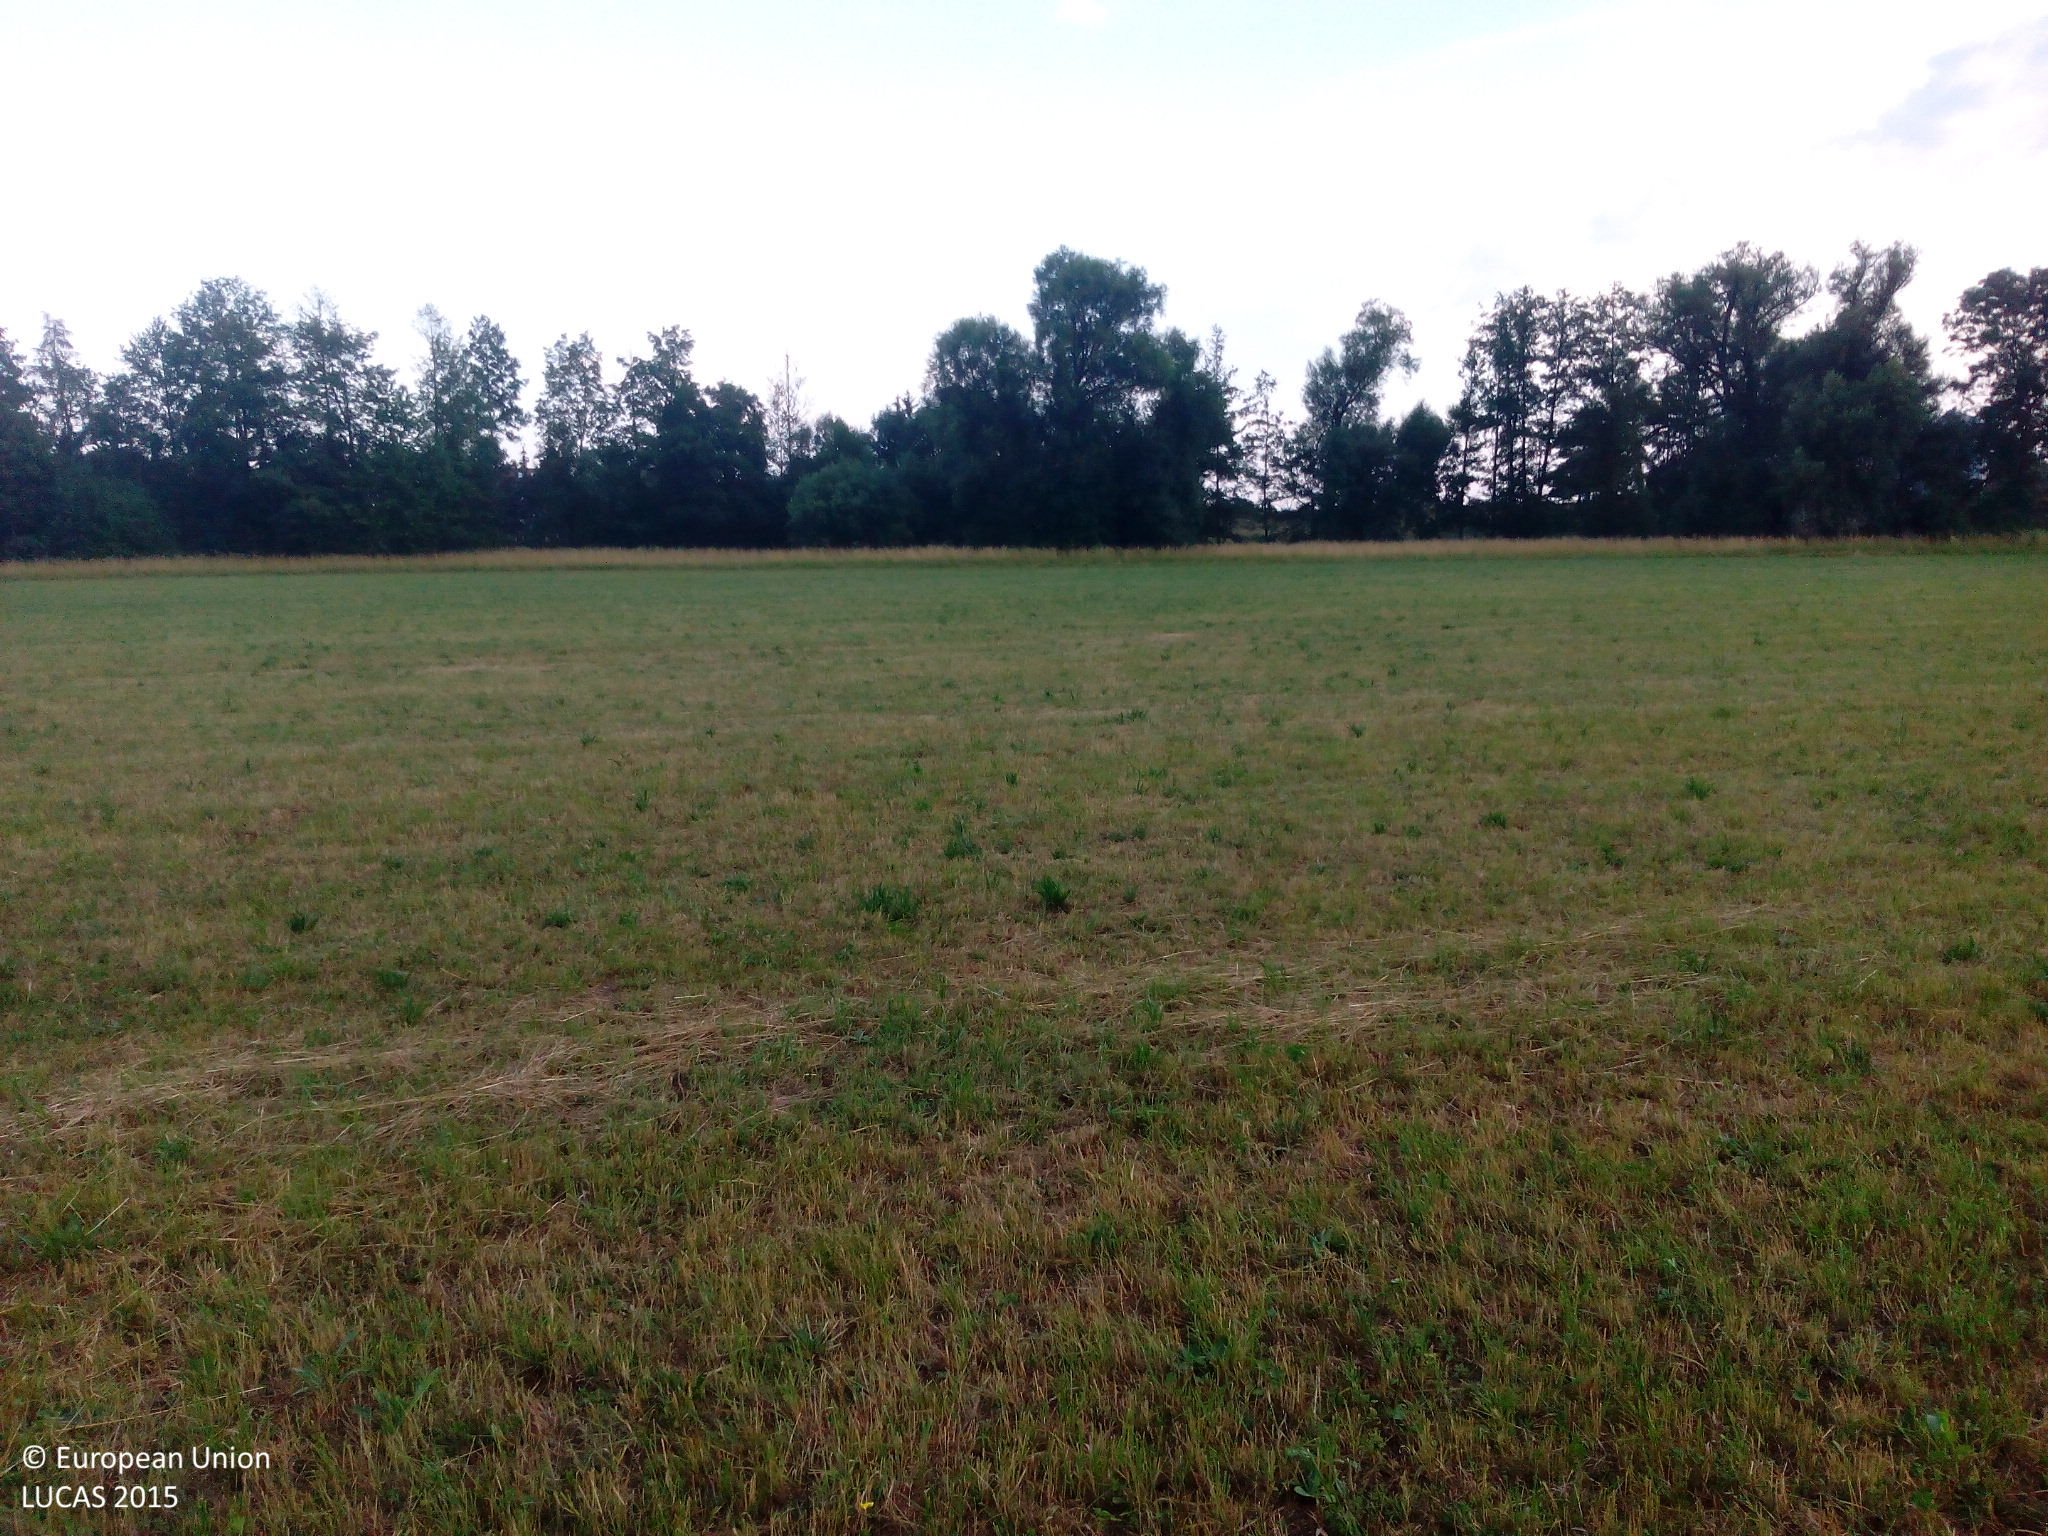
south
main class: Grassland
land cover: Grassland without tree/shrub cover
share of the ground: > 75 %
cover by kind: herbaceous plants 100 %
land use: Agriculture (excluding fallow land and kitchen gardens)
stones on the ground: < 10 %
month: July
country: DE
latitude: 49.9289
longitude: 10.9052
